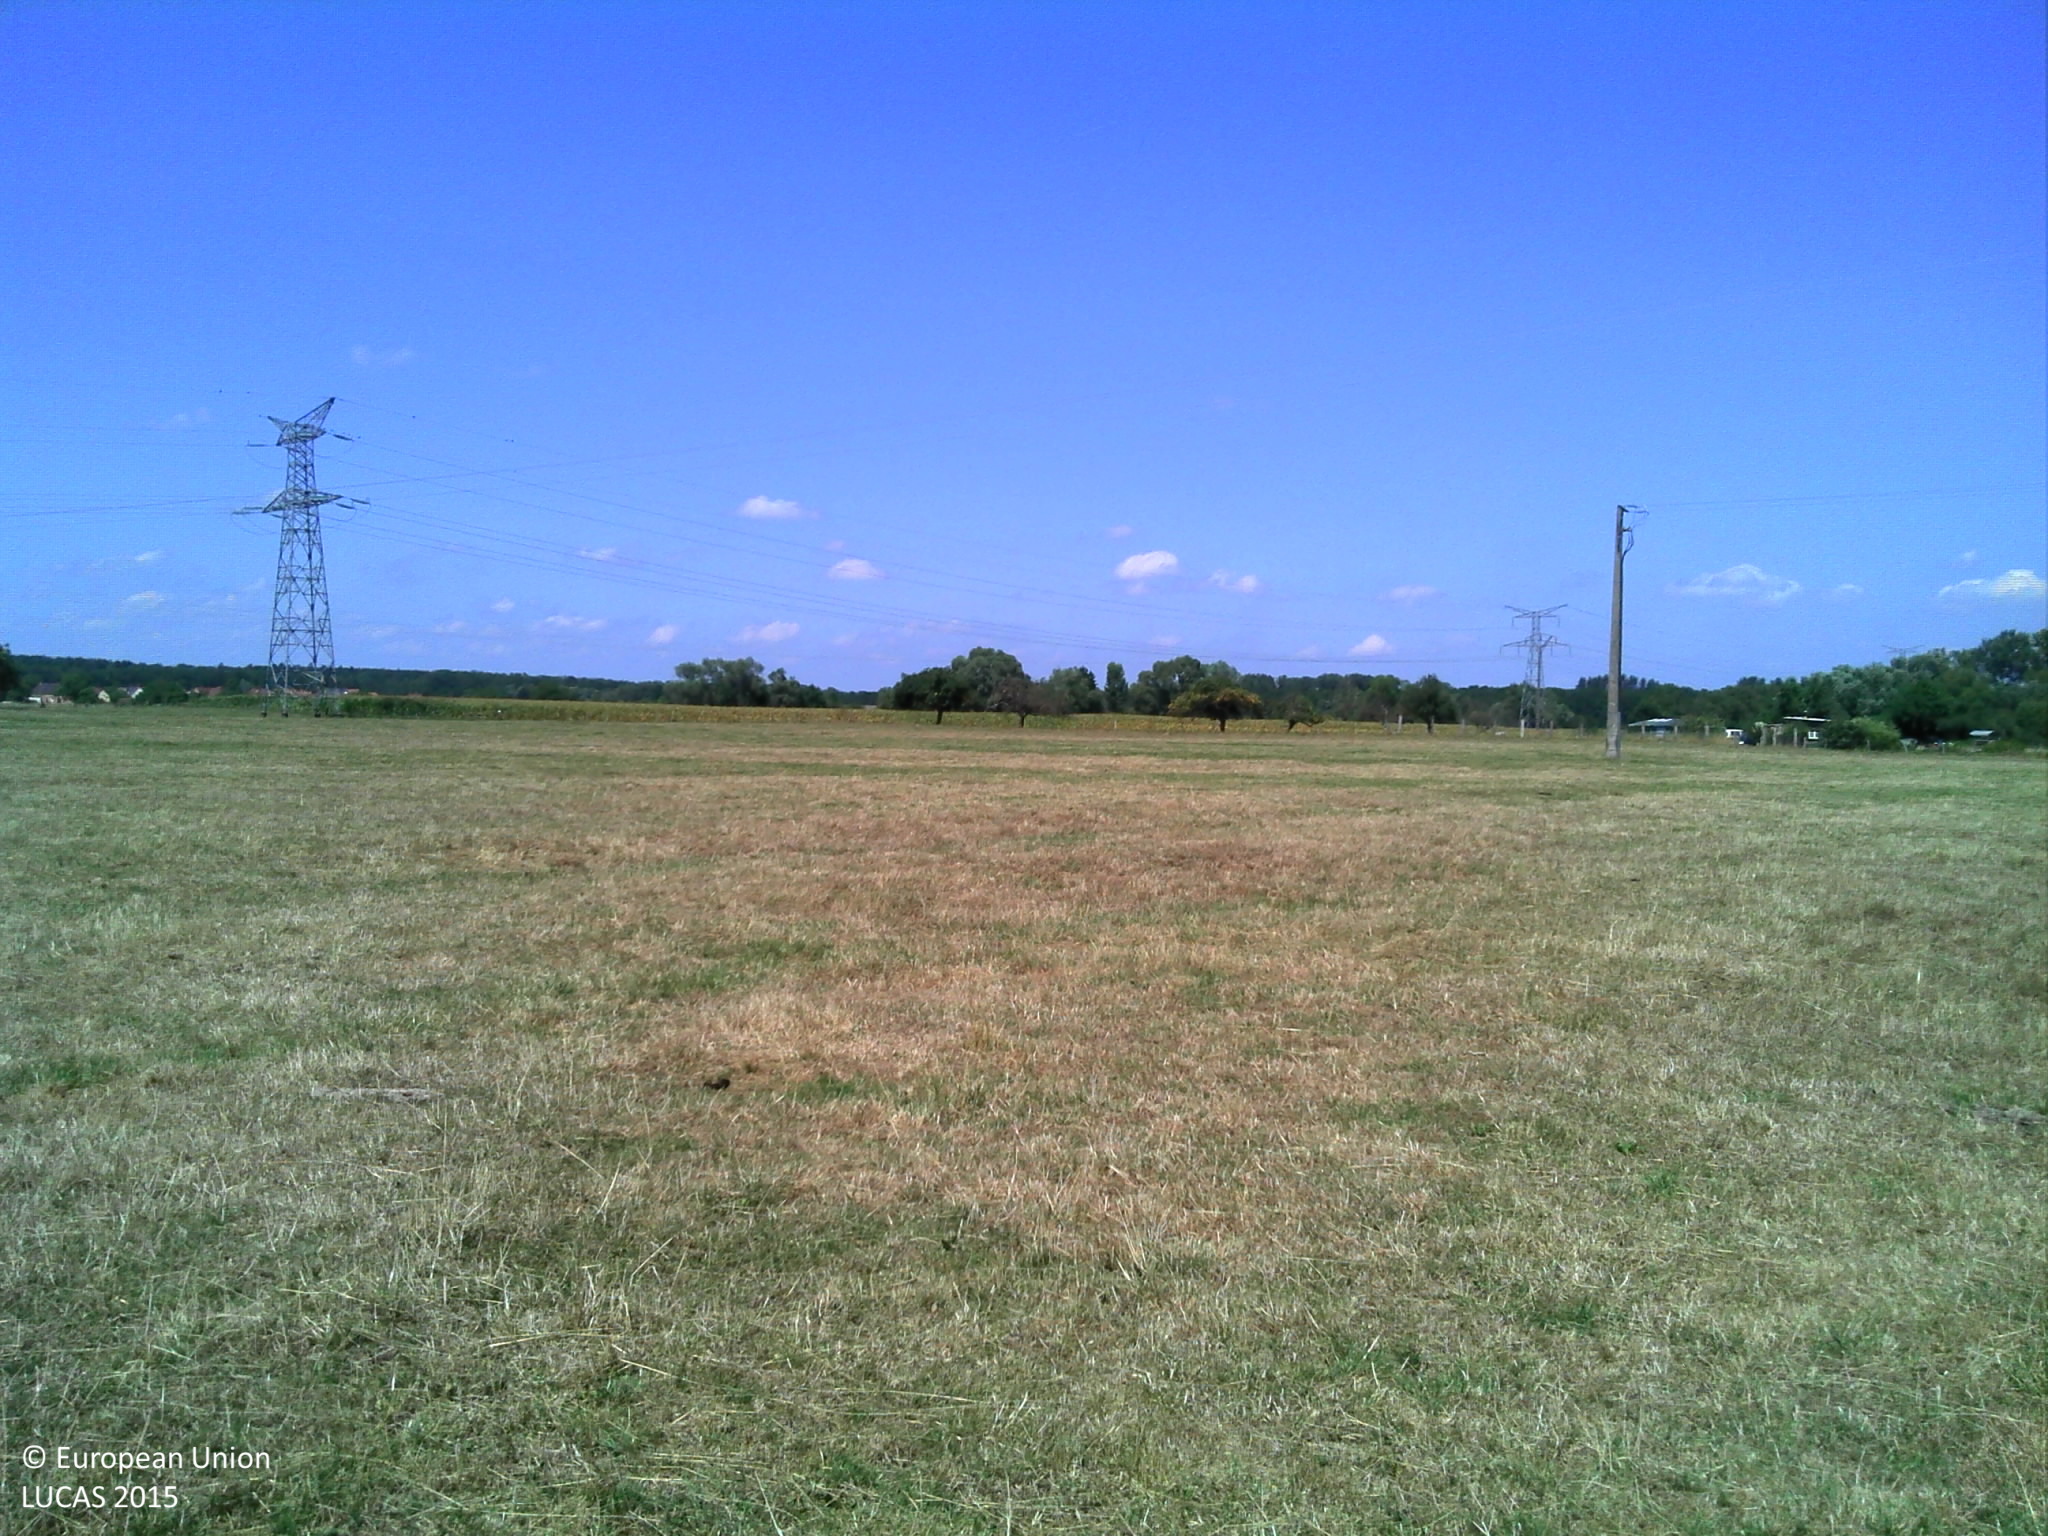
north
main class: Grassland
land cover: Grassland without tree/shrub cover
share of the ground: > 75 %
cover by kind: herbaceous plants 100 %
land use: Agriculture (excluding fallow land and kitchen gardens)
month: August
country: FR
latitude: 48.8543
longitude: 8.0517
